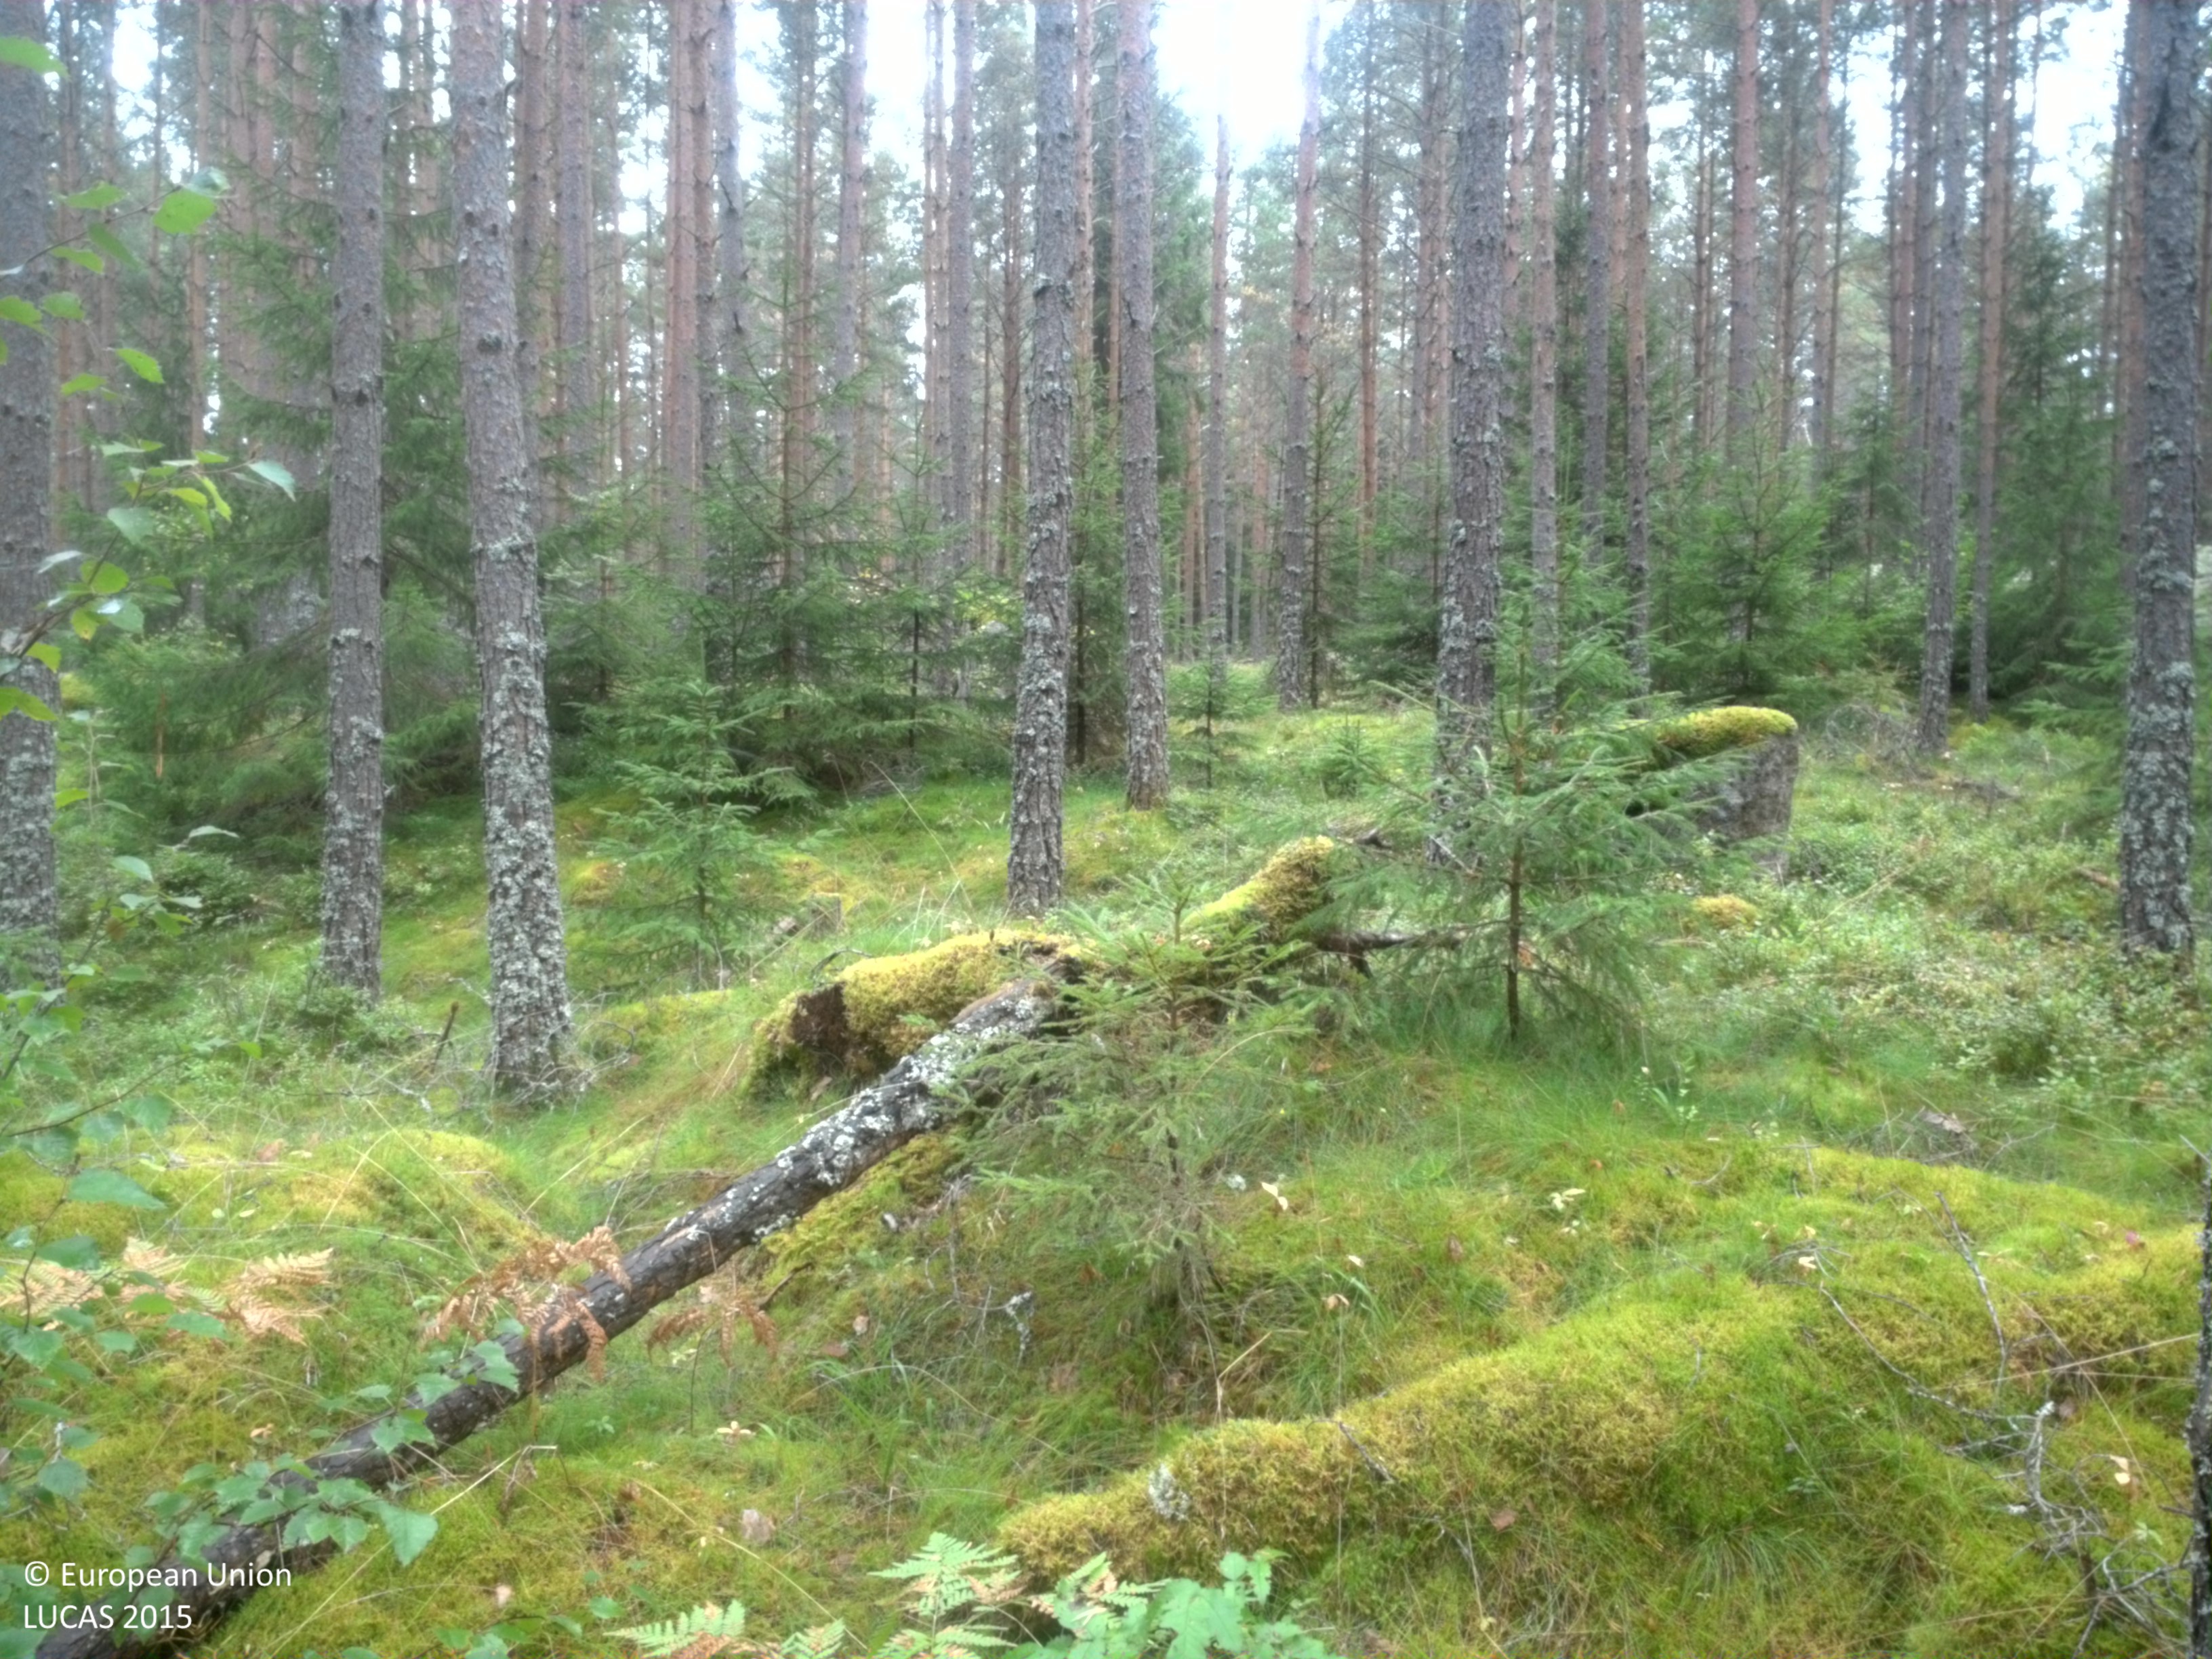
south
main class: Woodland
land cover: Pine dominated coniferous woodland
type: boreal forest
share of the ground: 50 - 75 %
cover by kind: coniferous forest trees 70 %, lichens and mosses 15 %, shrubs 10 %, herbaceous plants 5 %
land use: Forestry
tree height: > 5 m
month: September
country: SE
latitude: 59.6552
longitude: 15.5806
